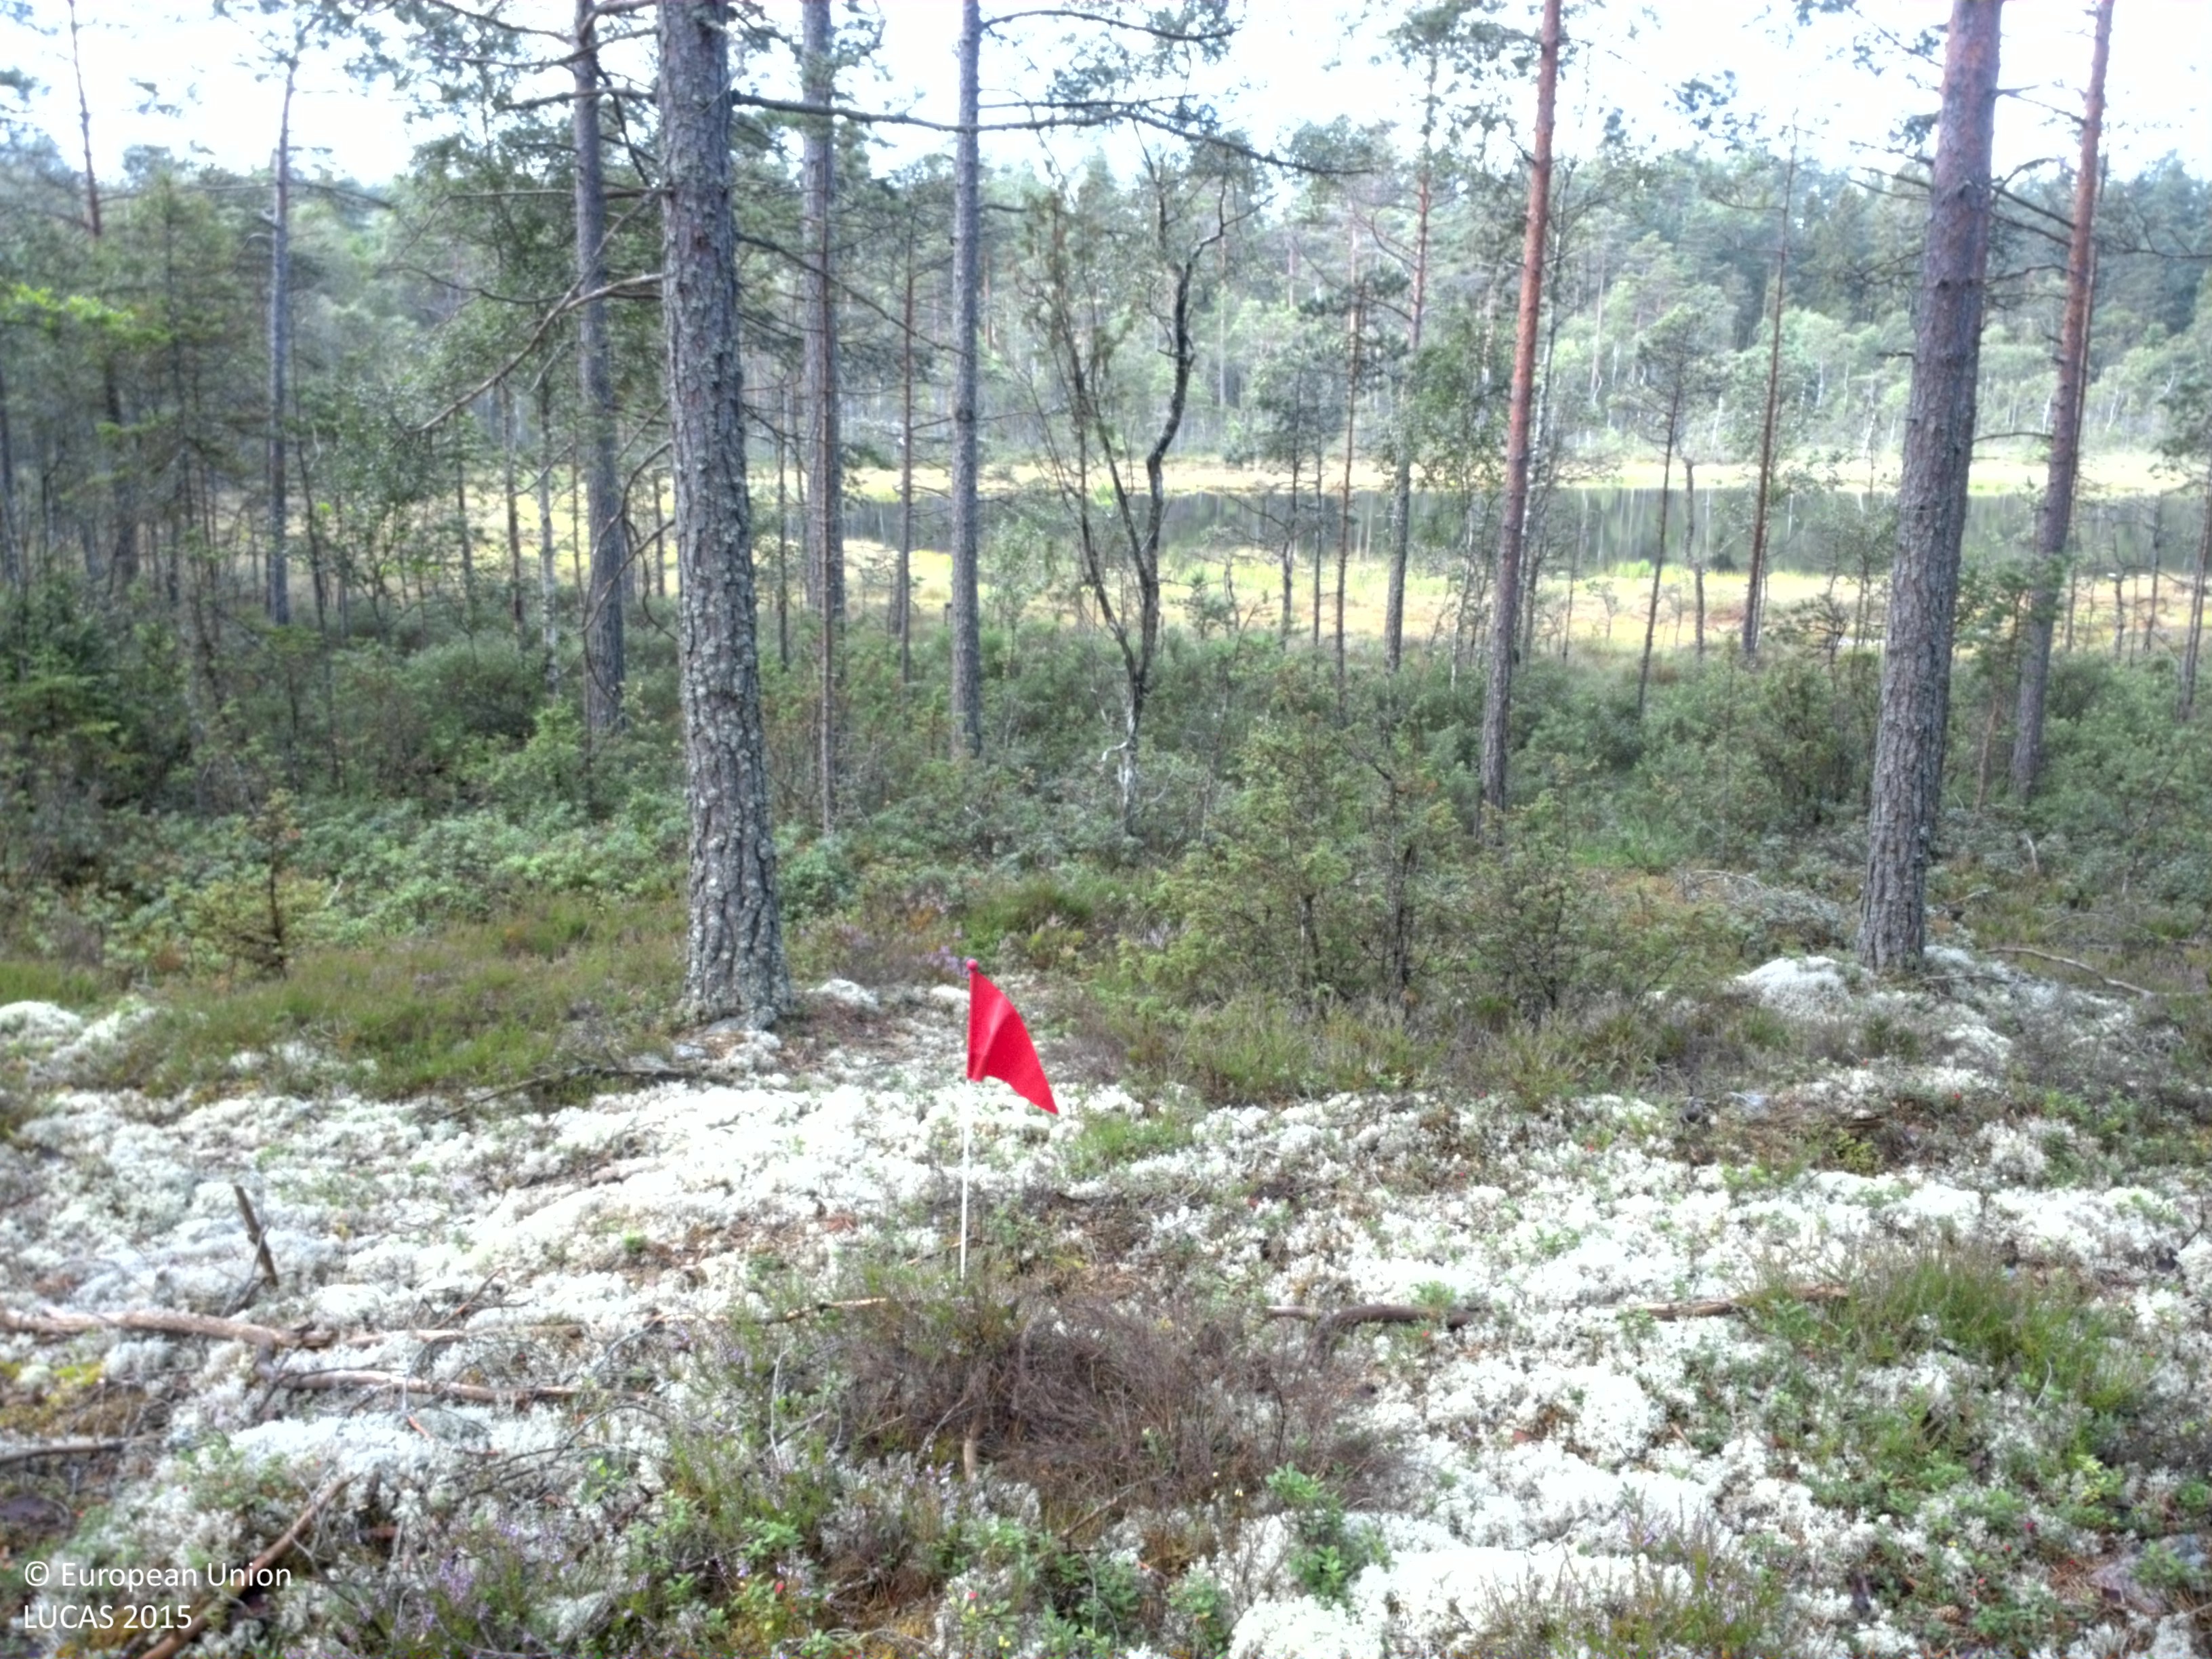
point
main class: Woodland
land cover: Pine dominated coniferous woodland
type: boreal forest
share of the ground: 50 - 75 %
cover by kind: coniferous forest trees 65 %, shrubs 20 %, lichens and mosses 10 %, broadleaved forest trees 5 %
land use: Forestry
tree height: > 5 m
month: August
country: SE
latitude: 59.3400
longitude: 11.8764
